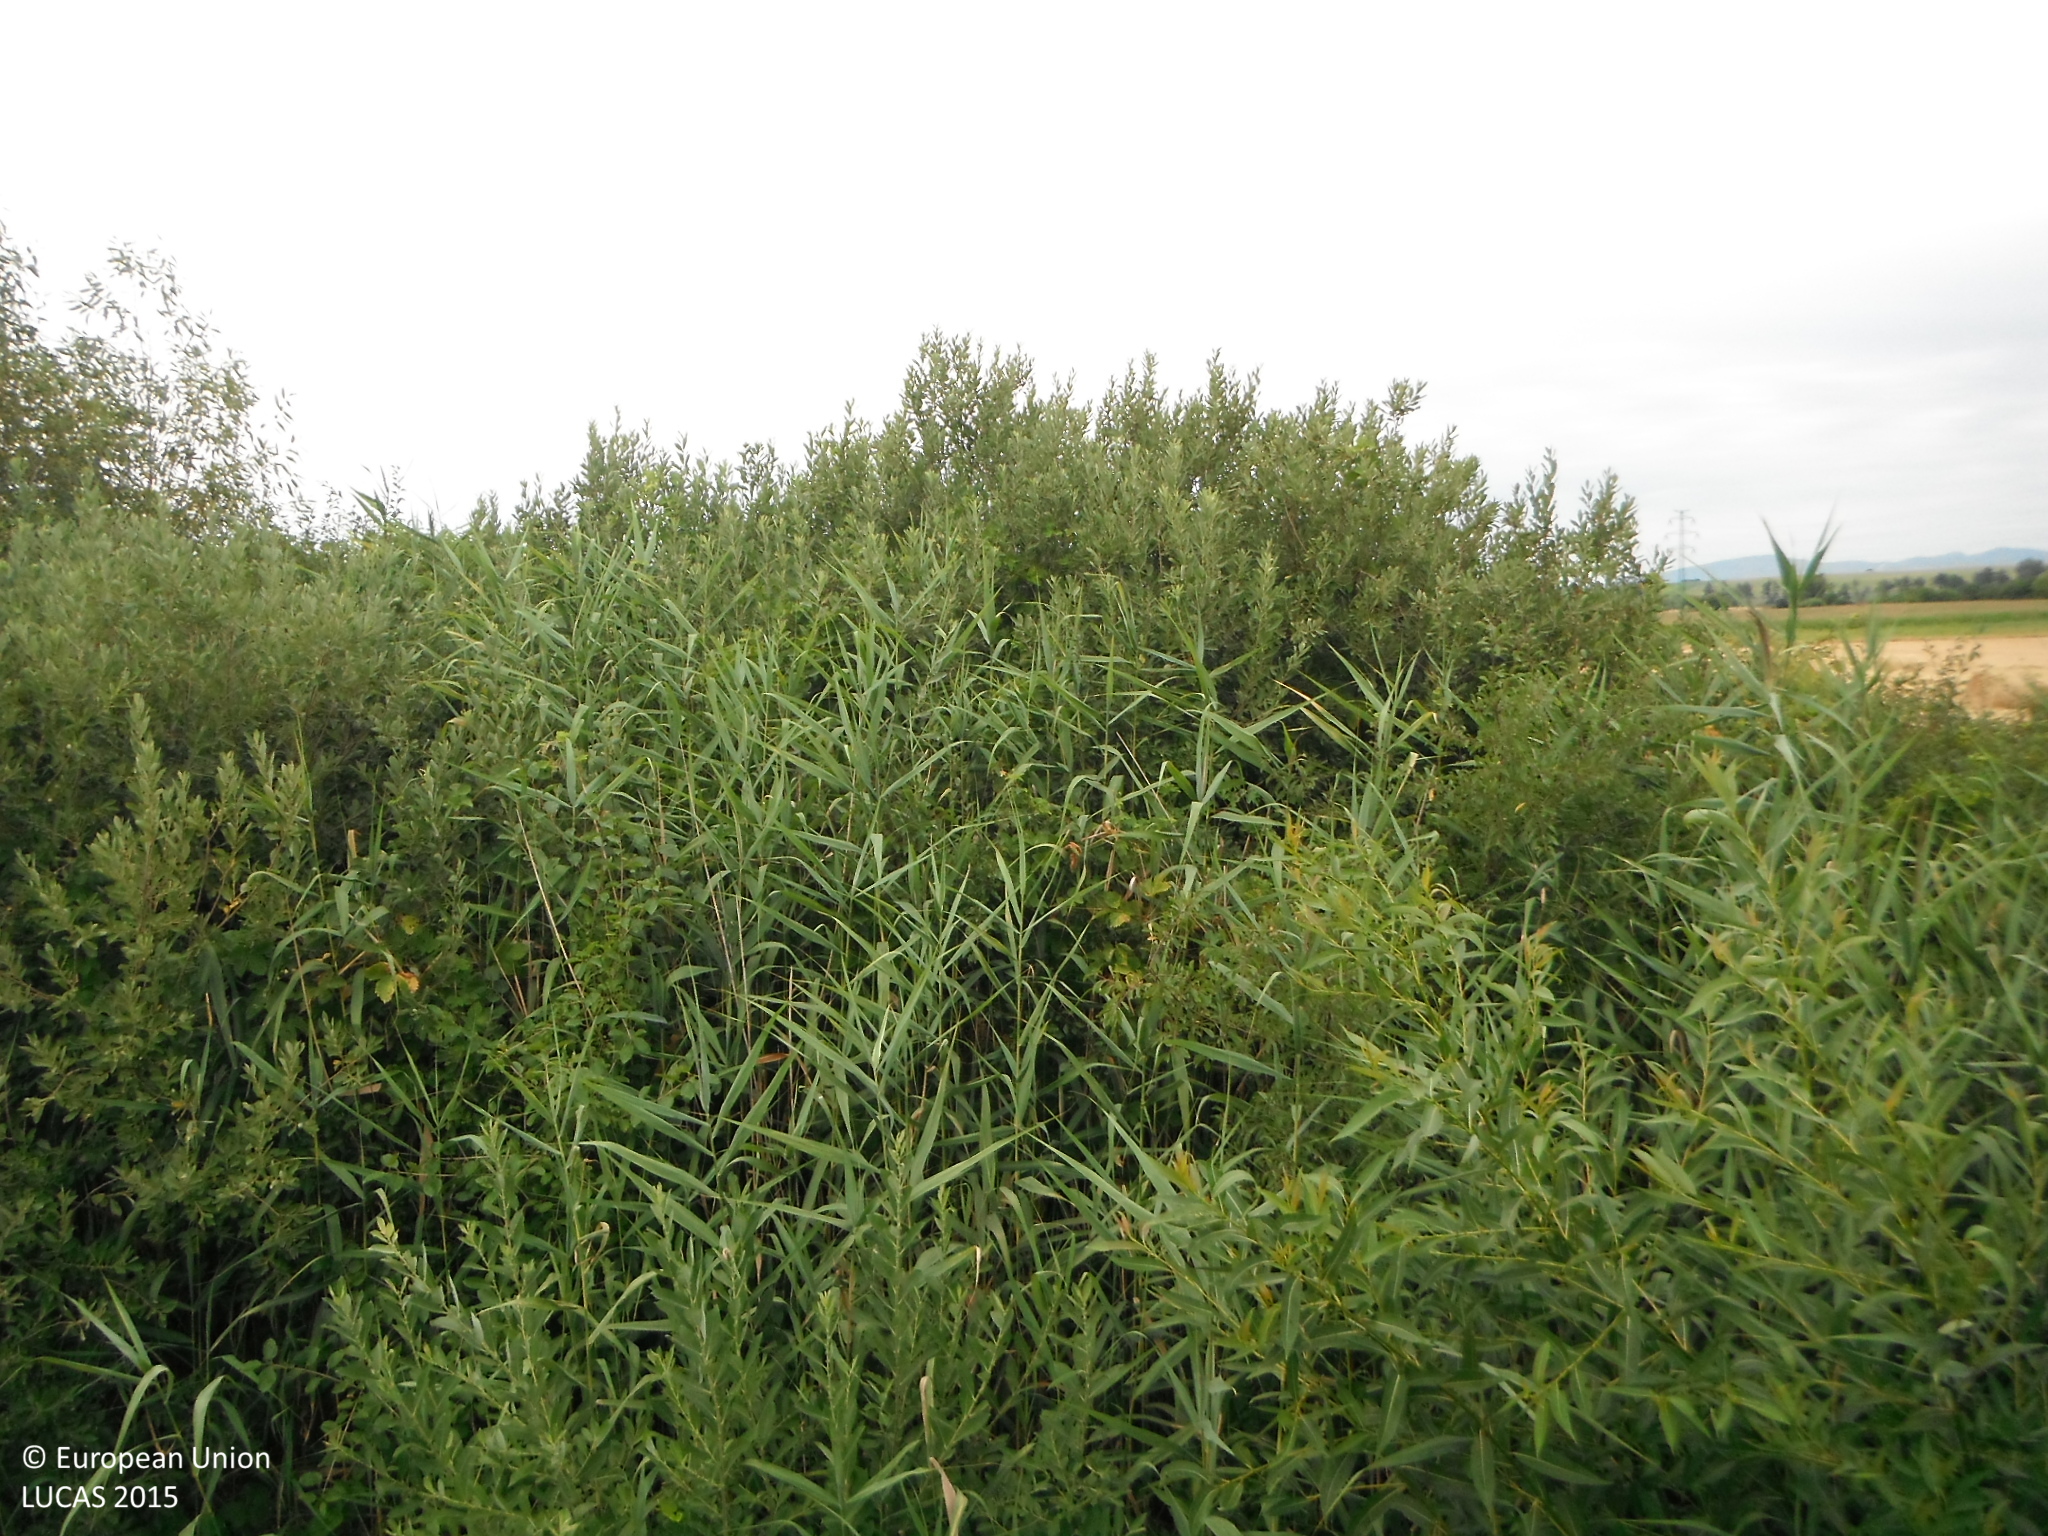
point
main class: Shrubland
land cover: Shrubland with sparse tree cover
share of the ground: > 75 %
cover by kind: shrubs 95 %, broadleaved forest trees 5 %
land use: Semi-natural and natural areas not in use
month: July
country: SK
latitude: 48.6352
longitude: 18.2796
